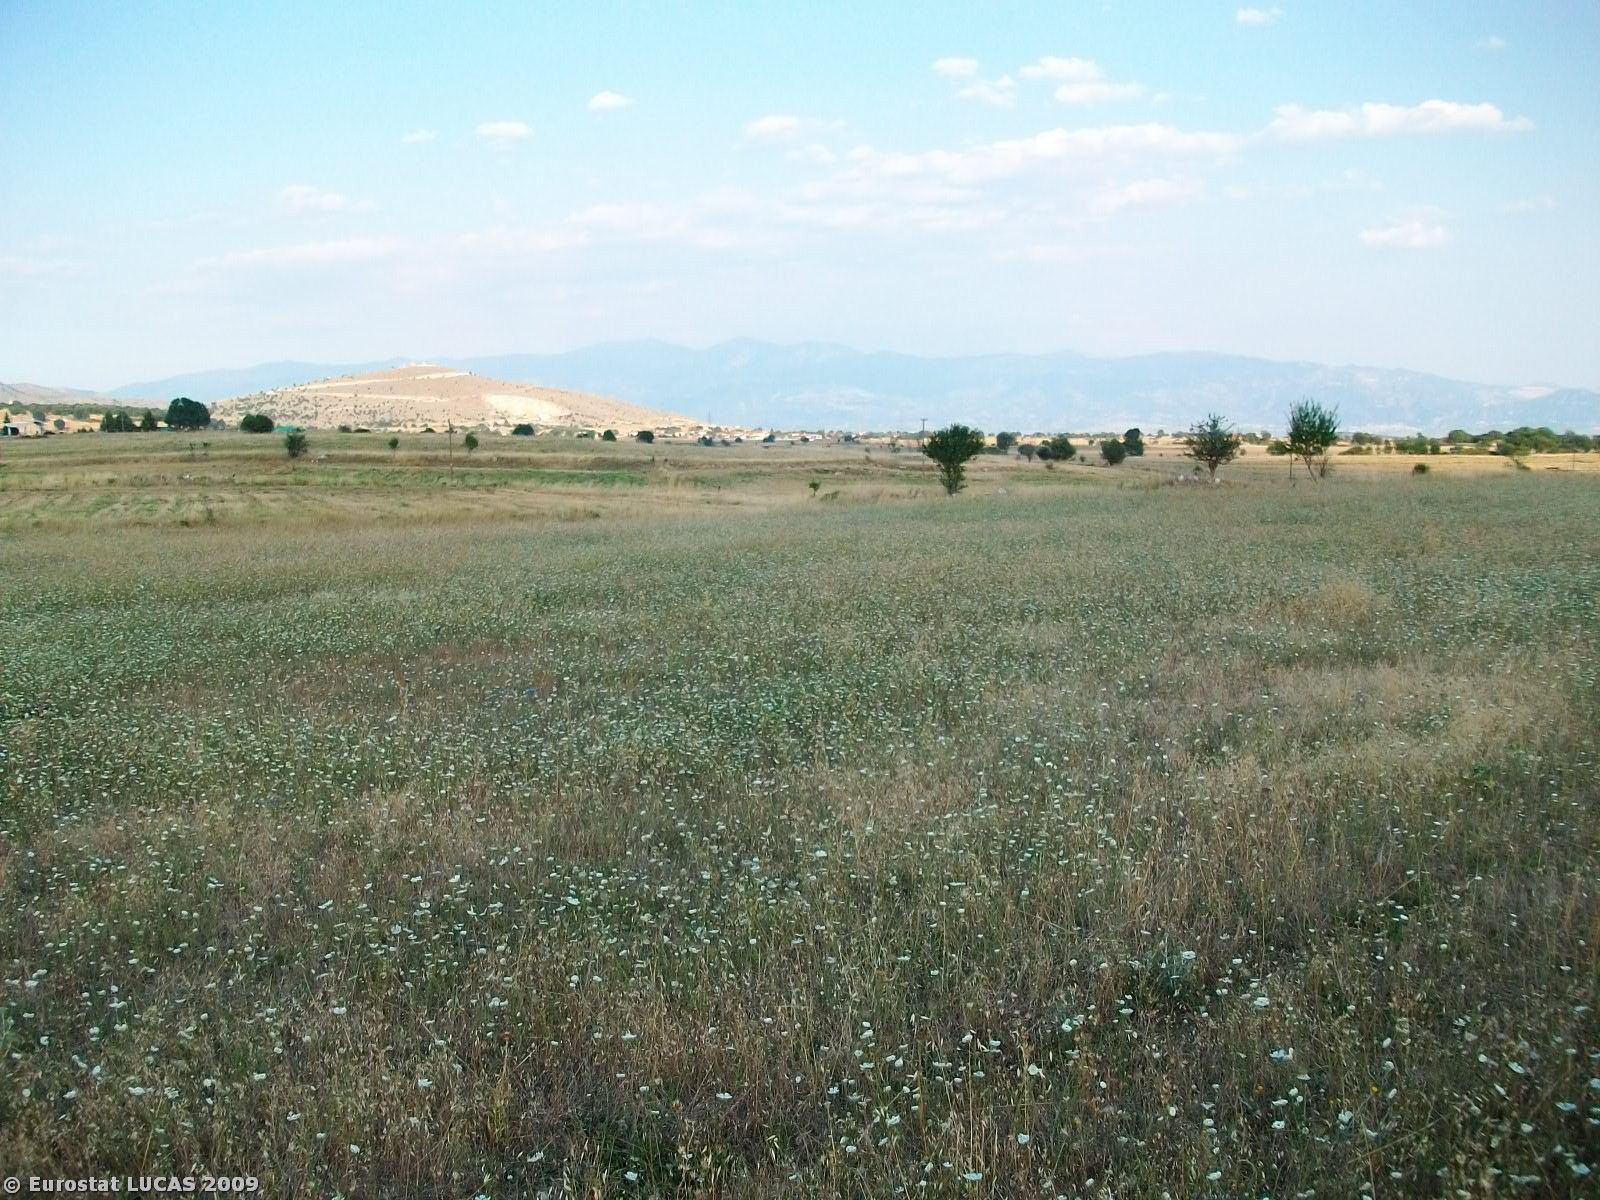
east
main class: Grassland
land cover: Spontaneously vegetated surfaces
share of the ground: > 75 %
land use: Fallow land
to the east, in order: Spontaneously vegetated surfaces; Fences; Grassland without tree/shrub cover; Durum wheat; Grass margins; Durum wheat
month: July
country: GR
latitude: 40.2966
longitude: 21.8389
